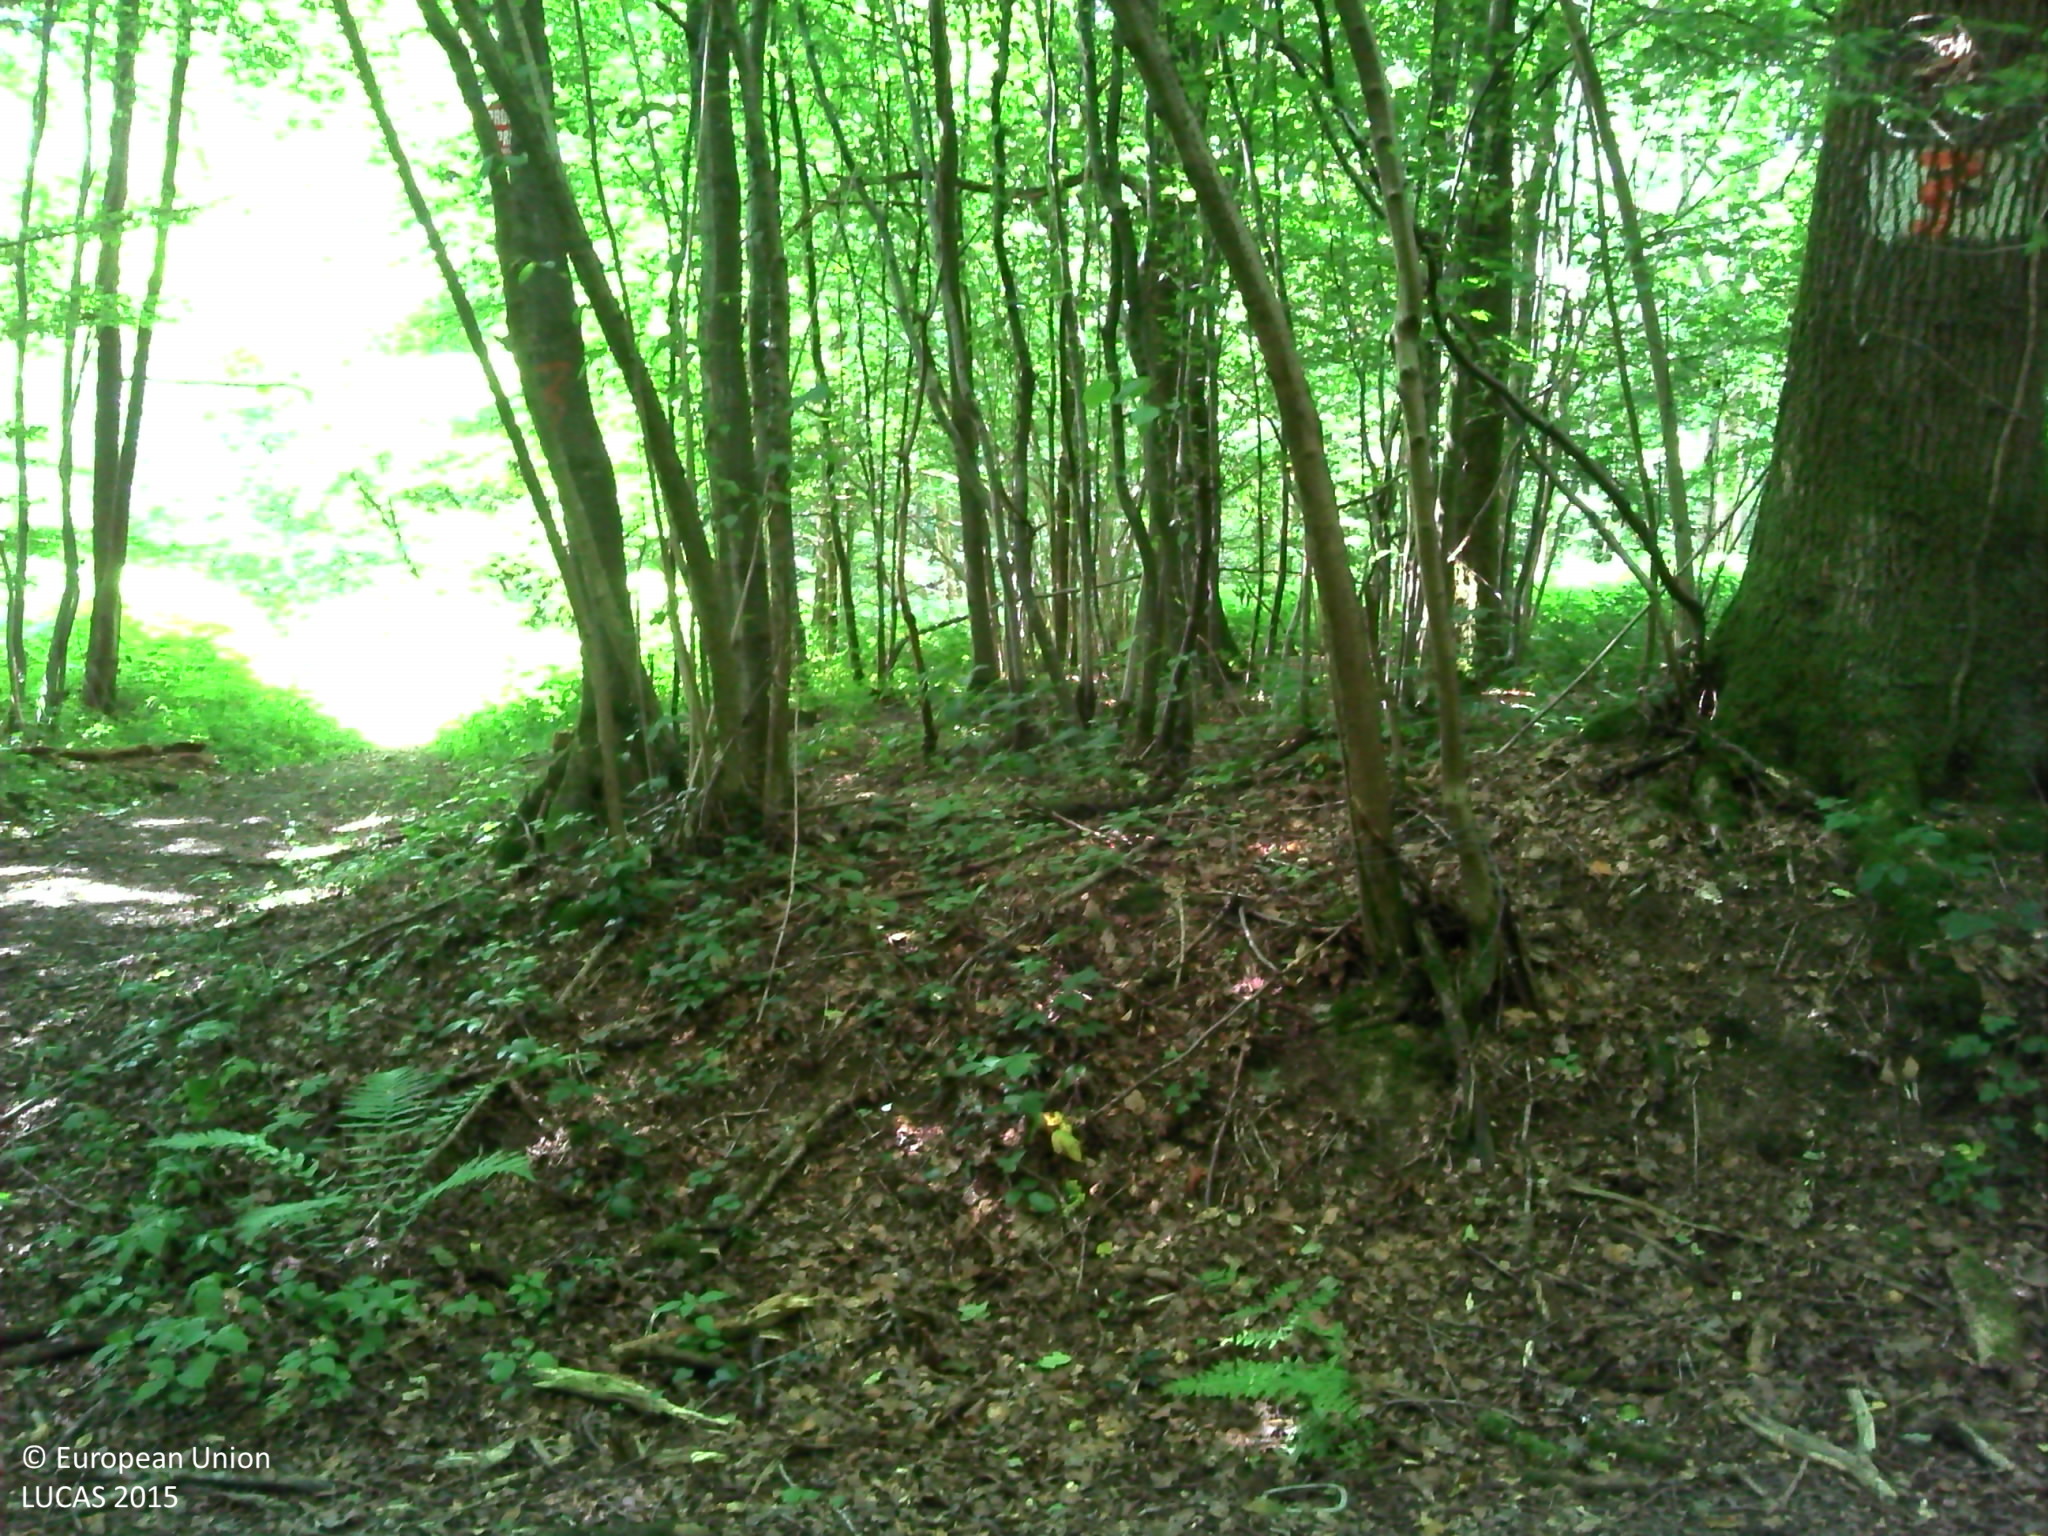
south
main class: Woodland
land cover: Broadleaved woodland
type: mesophytic deciduous forest
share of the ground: > 75 %
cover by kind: broadleaved forest trees 85 %, herbaceous plants 10 %, lichens and mosses 5 %
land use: Forestry
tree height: > 5 m
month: August
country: FR
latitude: 50.0145
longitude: 4.1196
